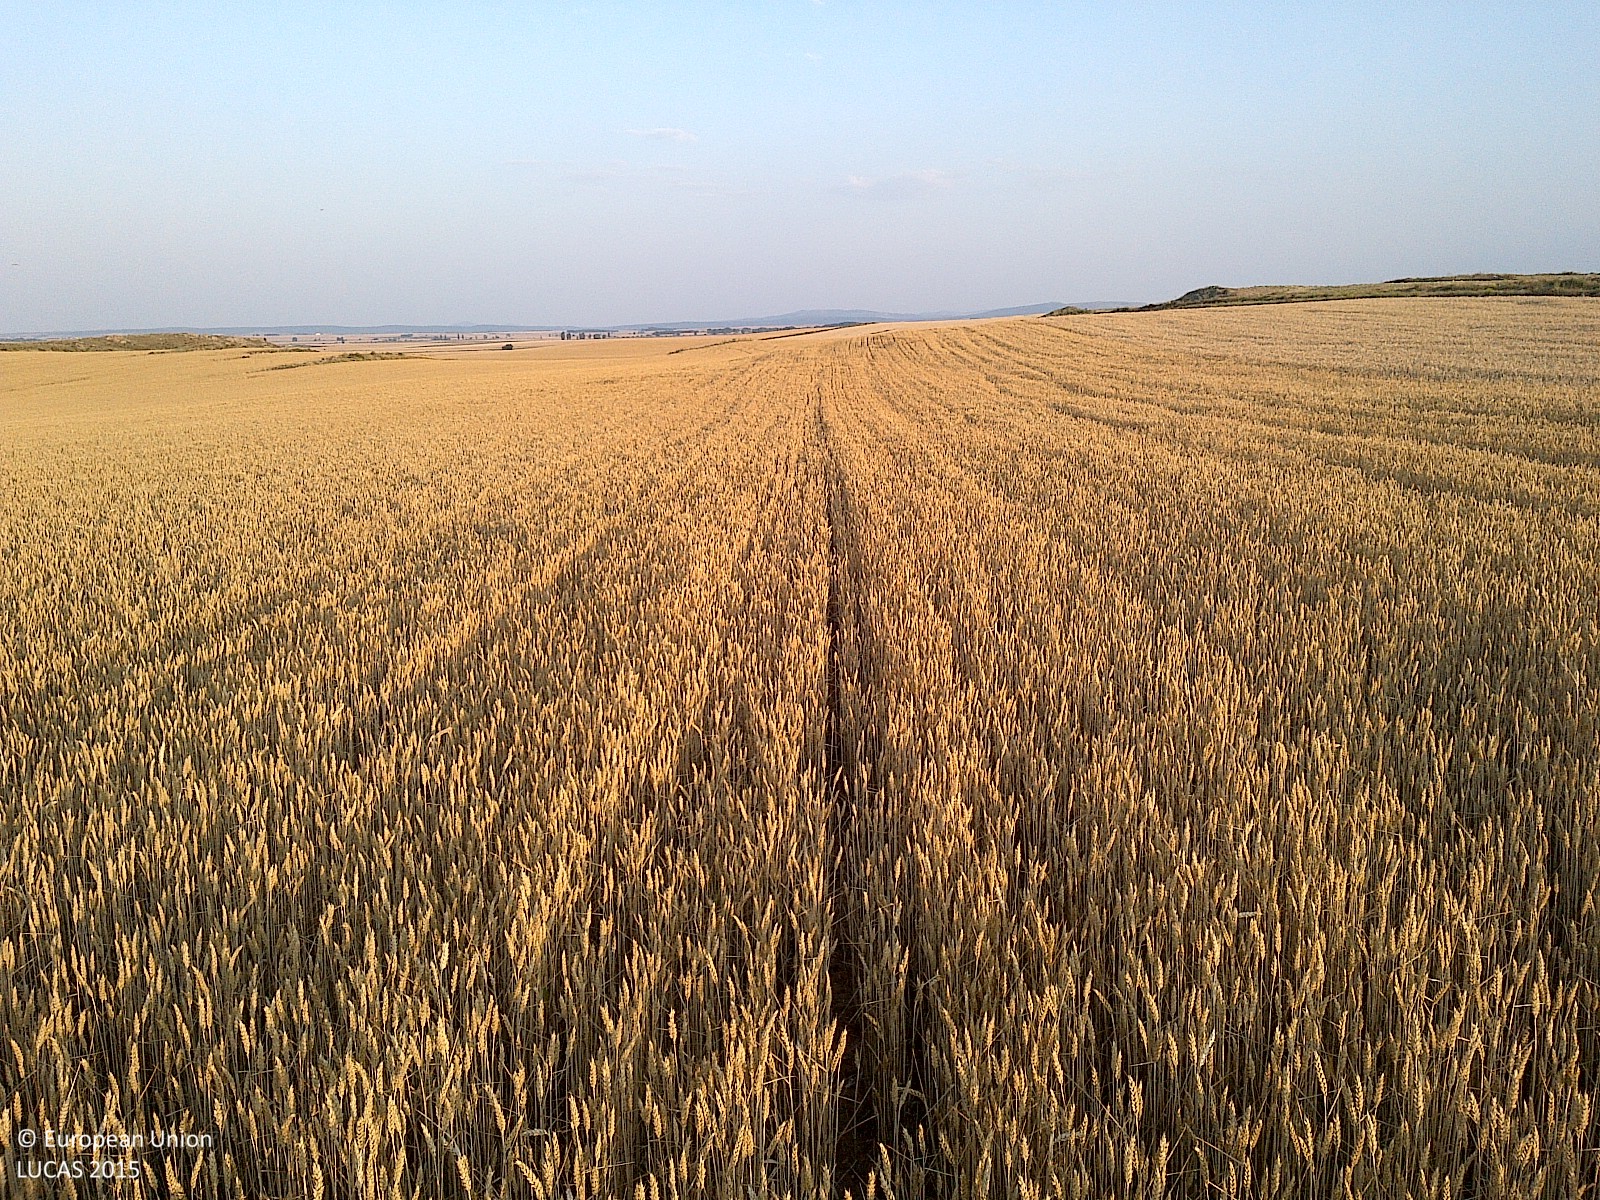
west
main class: Cropland
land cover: Common wheat
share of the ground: > 75 %
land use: Agriculture (excluding fallow land and kitchen gardens)
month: June
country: ES
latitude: 41.6910
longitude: -2.2296
